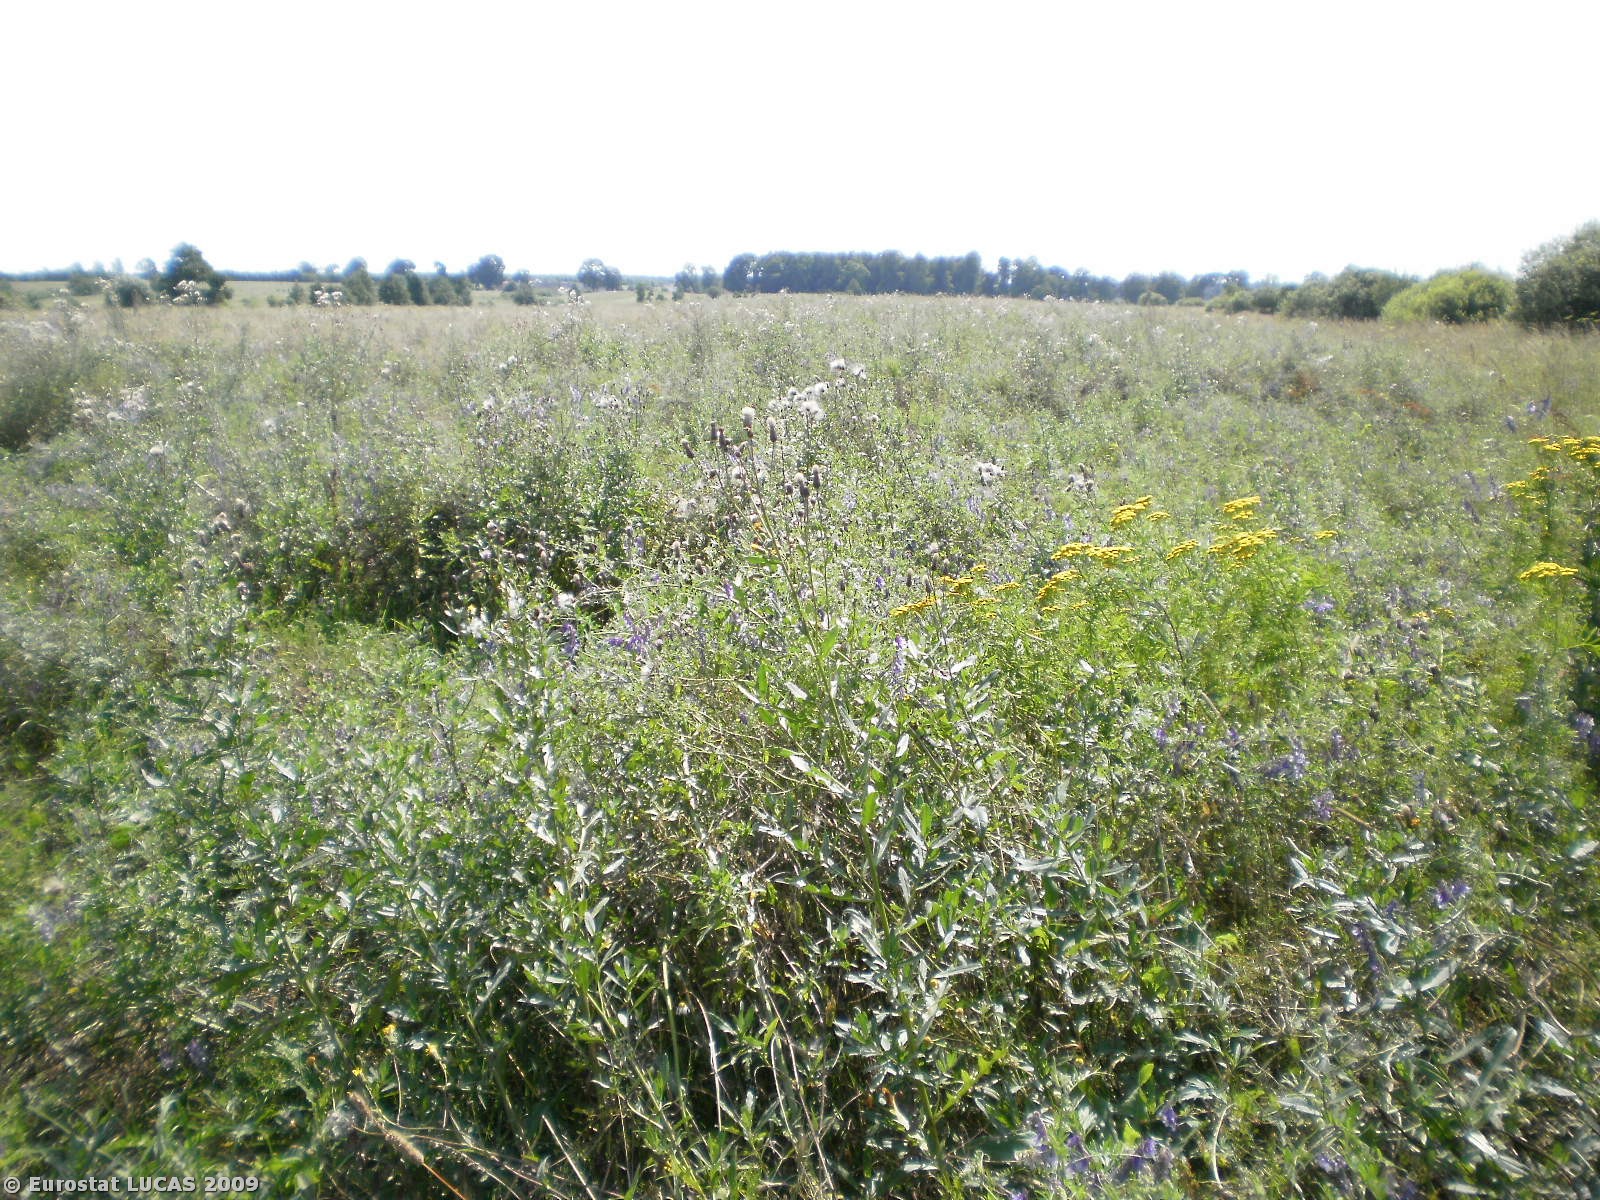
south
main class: Shrubland
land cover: Shrubland with sparse tree cover
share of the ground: > 75 %
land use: Unused
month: July
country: PL
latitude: 53.8929
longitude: 20.6444
